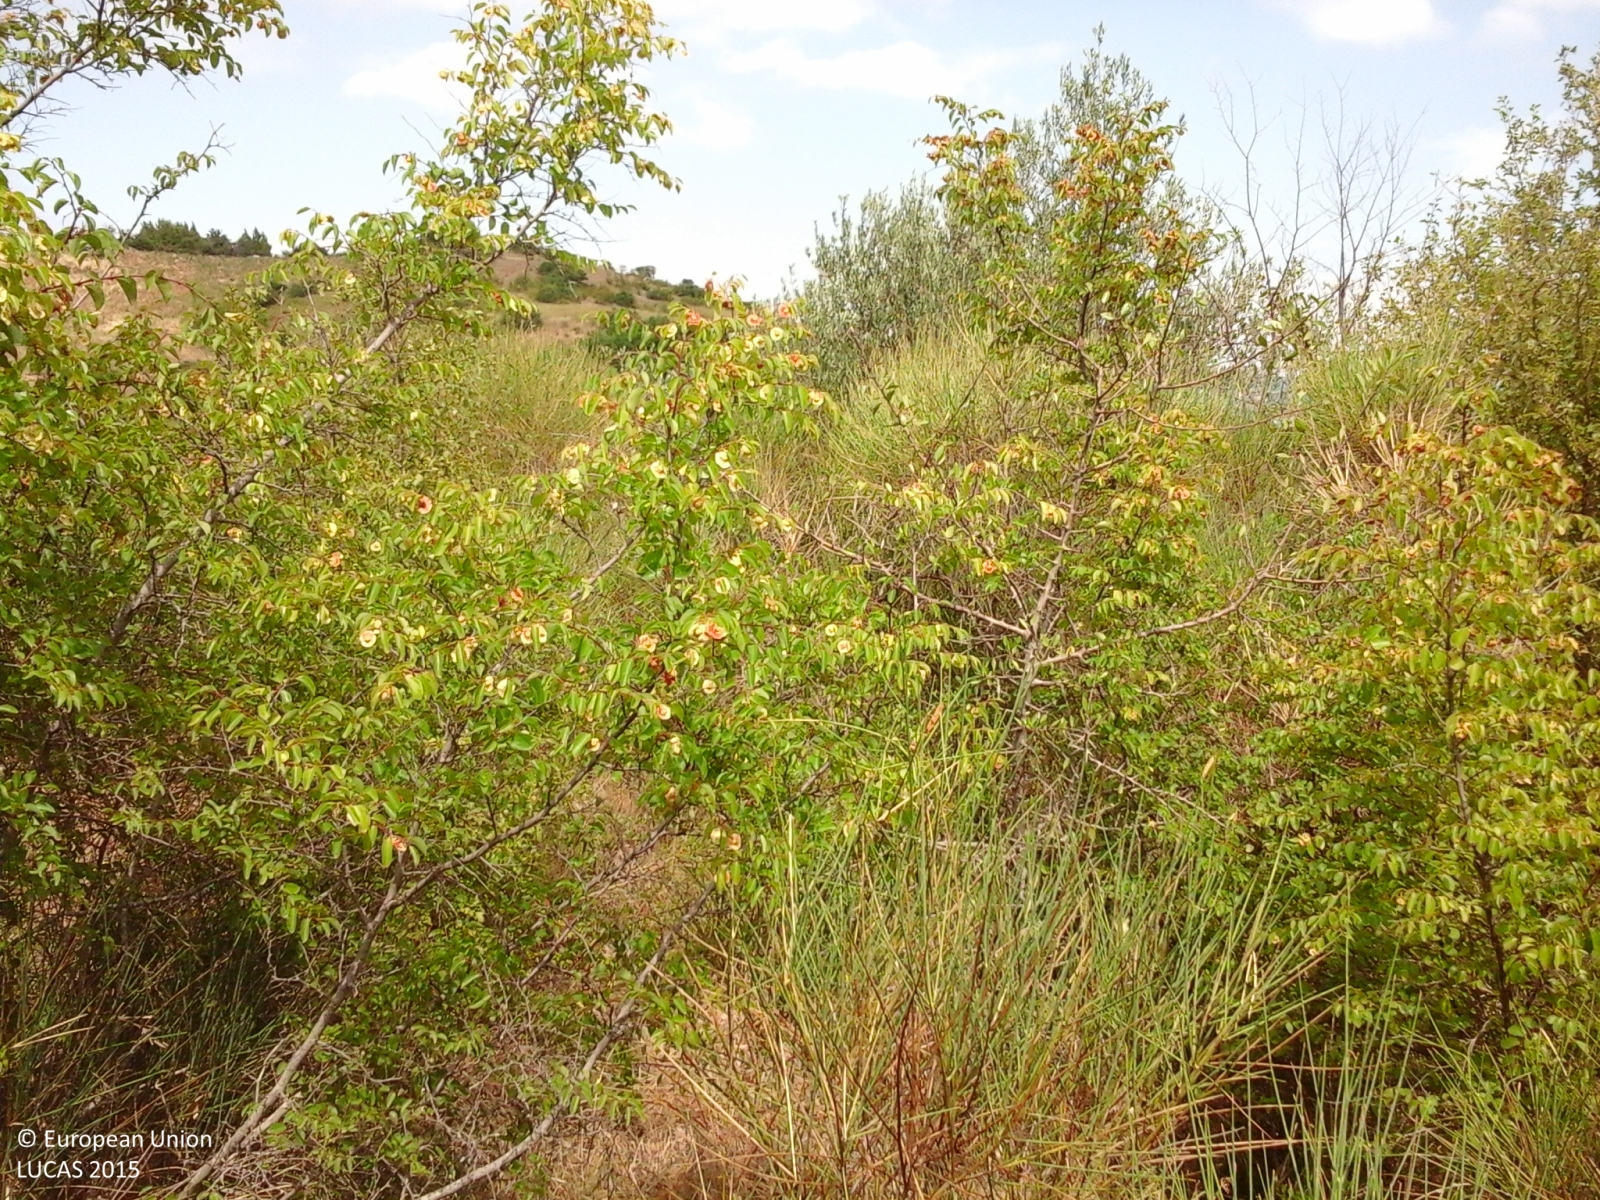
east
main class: Shrubland
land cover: Shrubland with sparse tree cover
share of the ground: > 75 %
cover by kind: shrubs 95 %, broadleaved forest trees 5 %
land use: Abandoned areas
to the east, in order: Shrubland with sparse tree cover; Artificial constructions in urban areas; Shrubland with sparse tree cover; Grassland with sparse tree/shrub cover
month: July
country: IT
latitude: 41.7471
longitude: 14.7343
